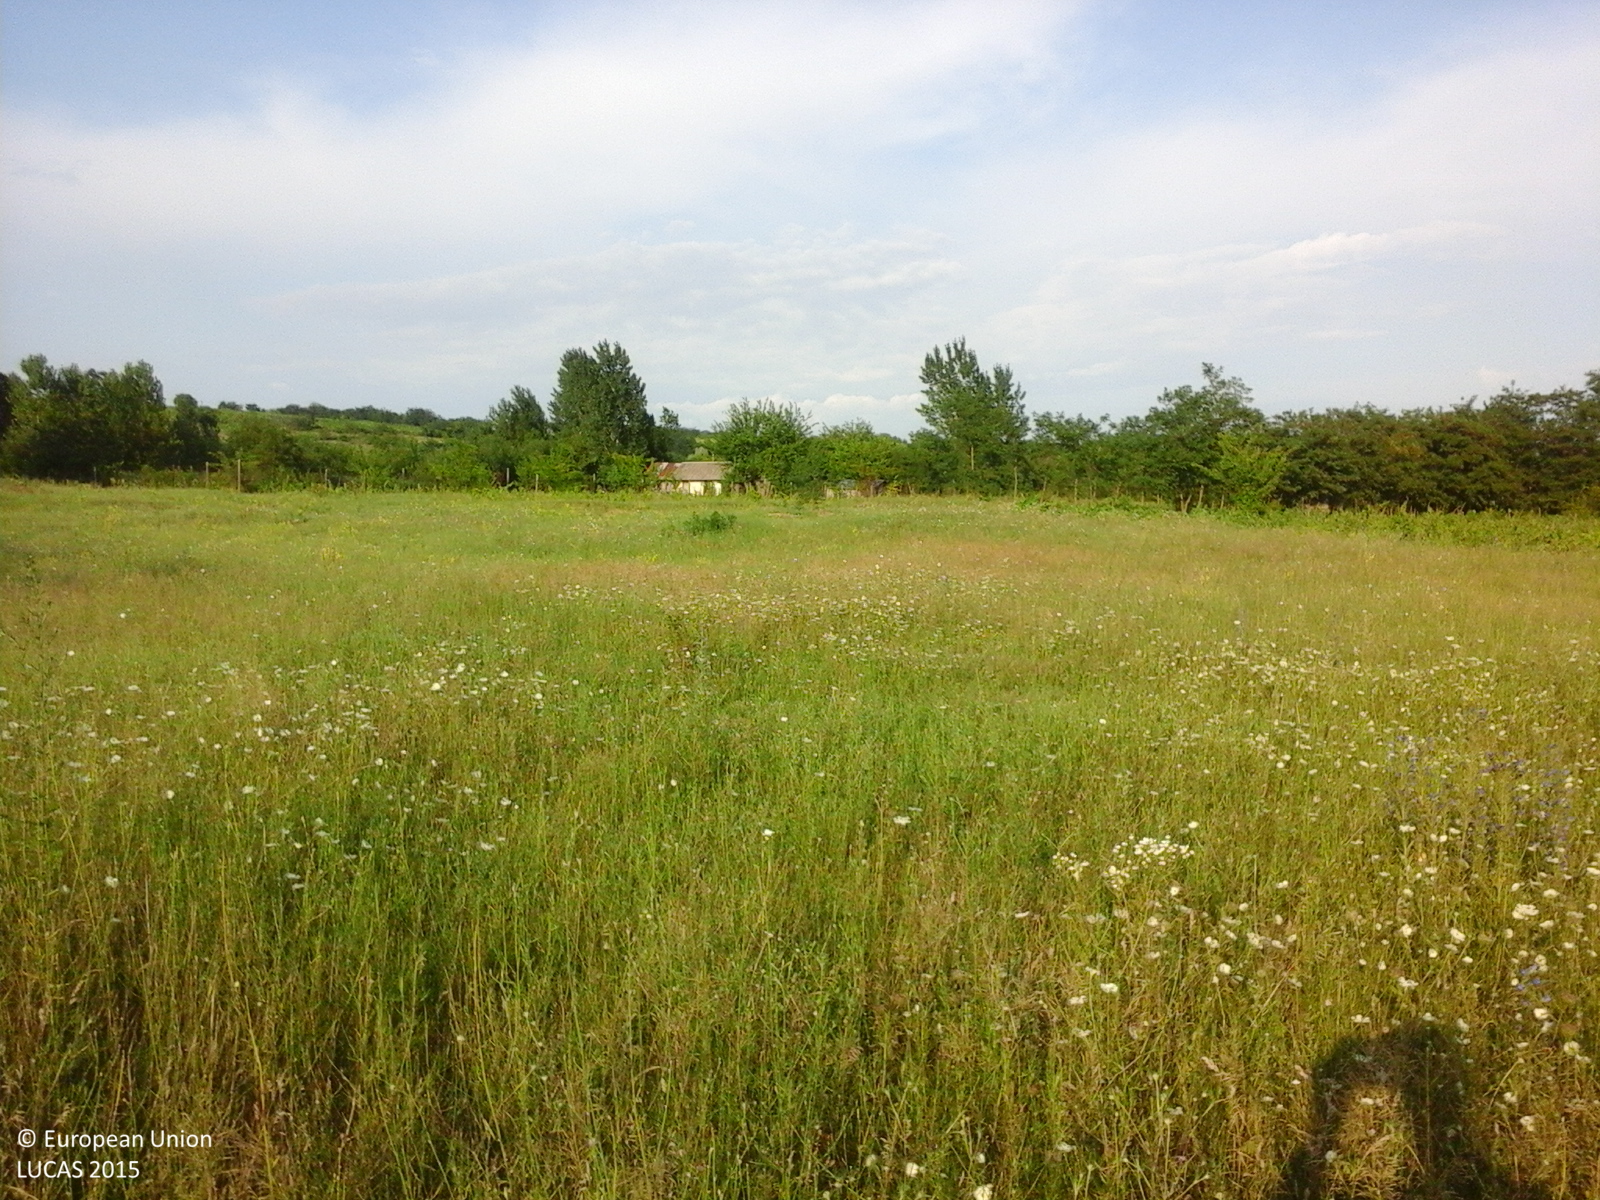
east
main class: Grassland
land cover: Grassland without tree/shrub cover
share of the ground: > 75 %
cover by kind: herbaceous plants 100 %
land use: Agriculture (excluding fallow land and kitchen gardens)
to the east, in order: Grassland without tree/shrub cover; Tracks; Grassland without tree/shrub cover; Lines of trees; Grassland without tree/shrub cover; Vineyards; Fences; Grassland with sparse tree/shrub cover; Fences; Broadleaved woodland; Grassland without tree/shrub cover; Broadleaved woodland; Grassland without tree/shrub cover; Tracks
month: July
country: RO
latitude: 43.7729
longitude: 24.1842
